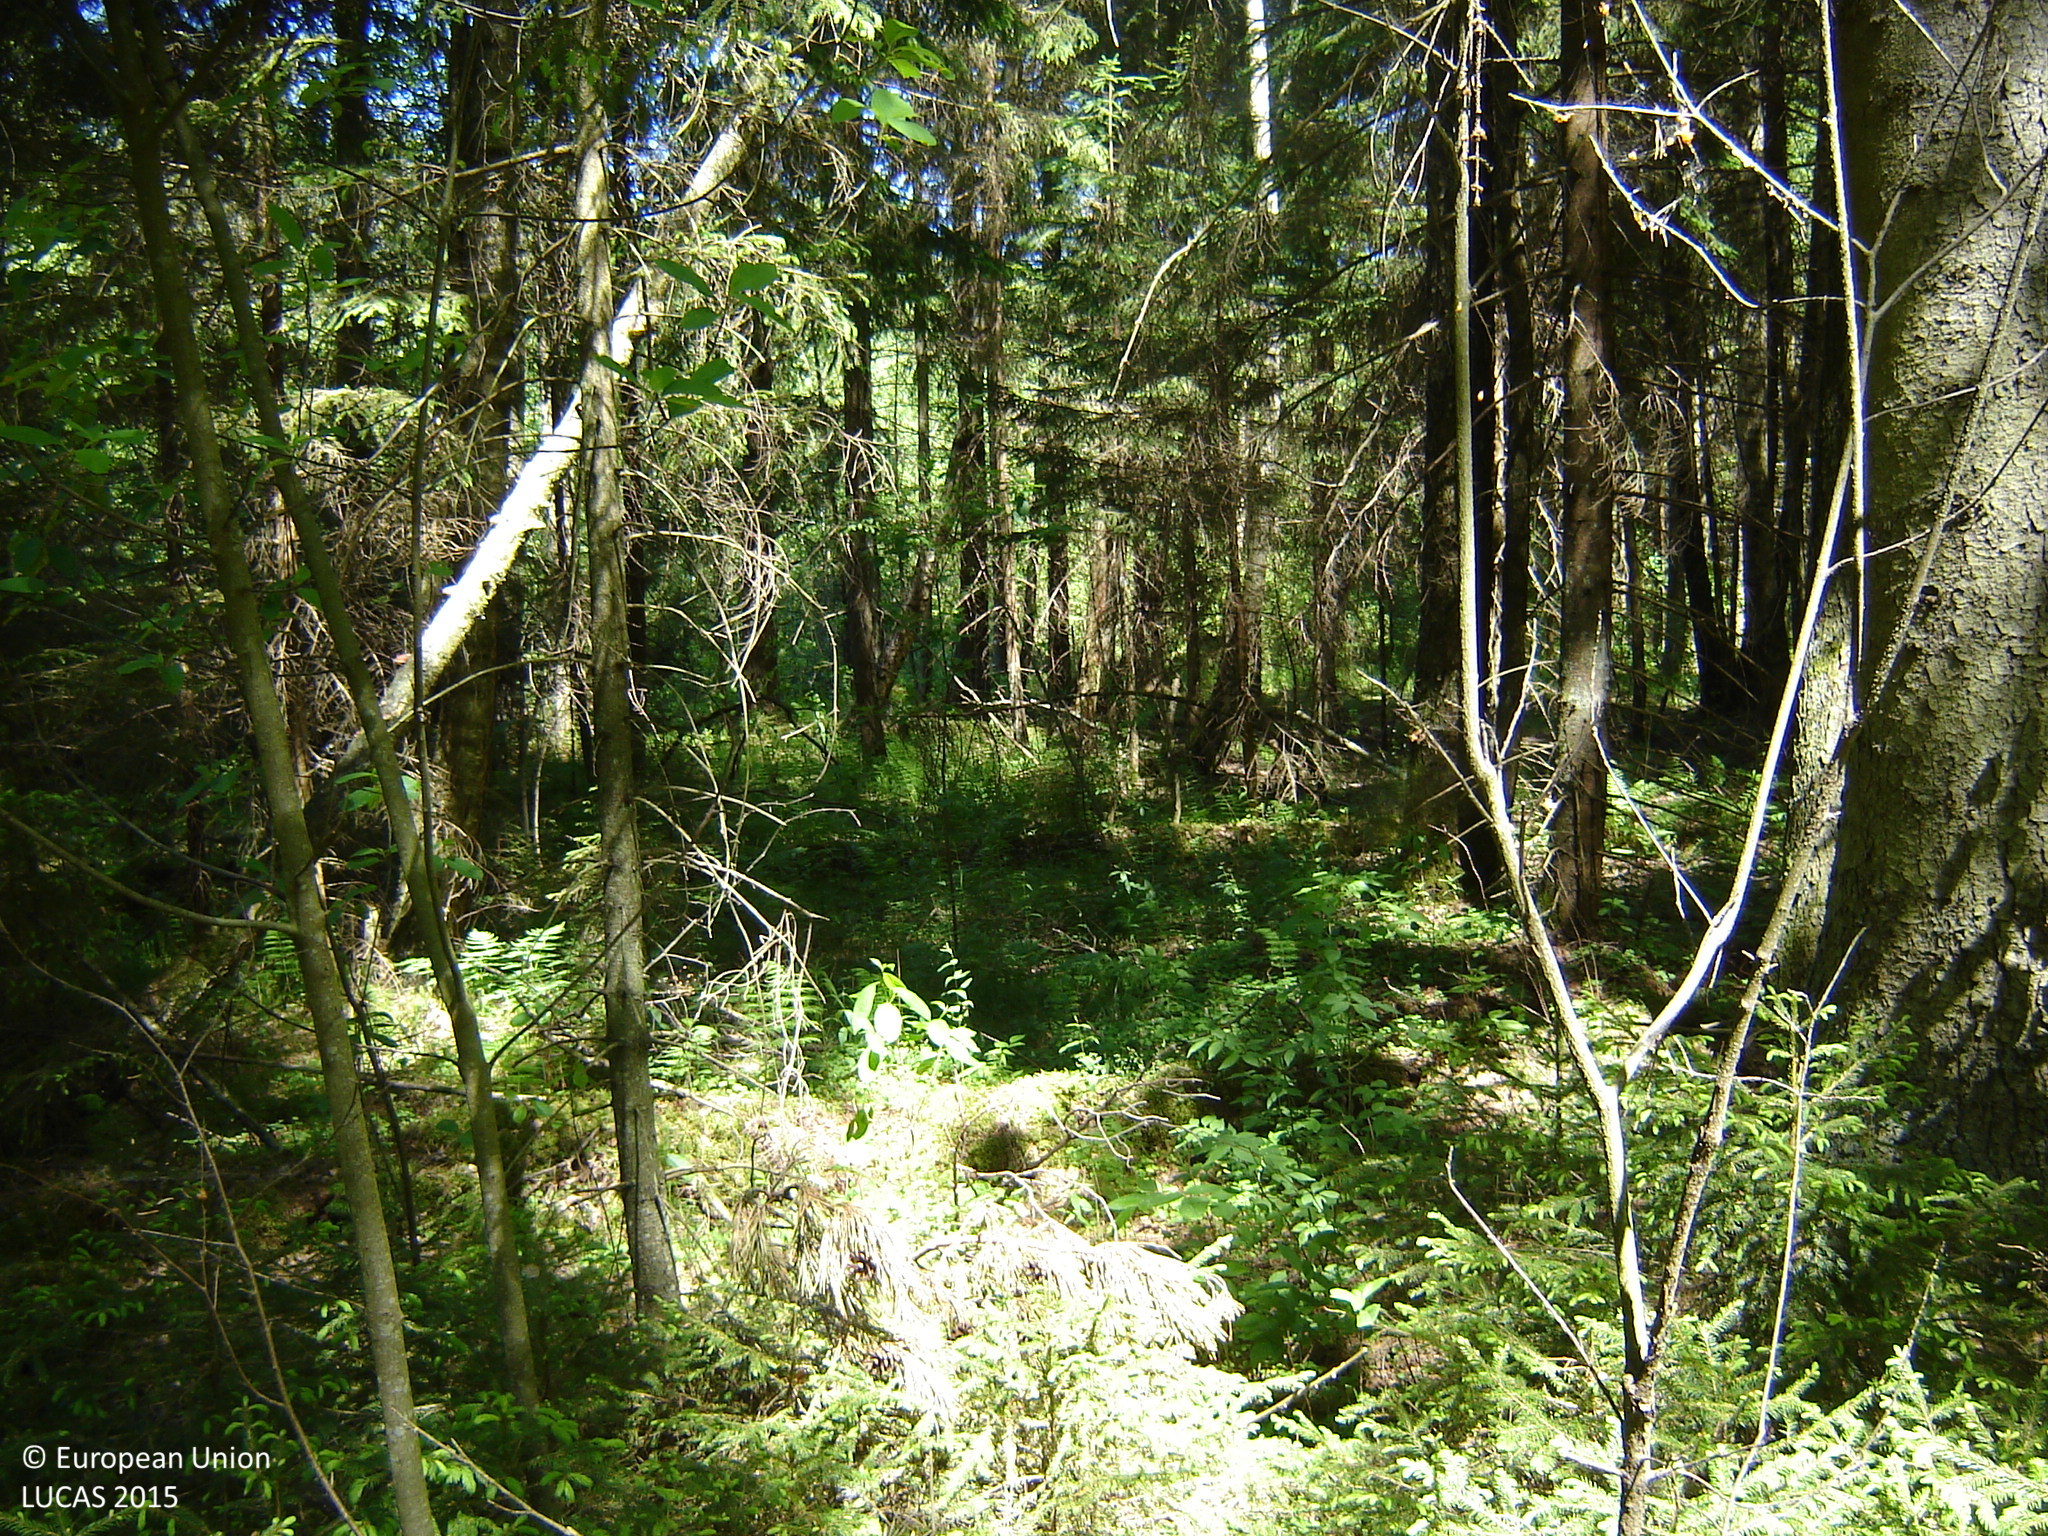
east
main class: Woodland
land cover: Spruce dominated coniferous woodland
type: hemiboreal forest and nemoral coniferous forest and mixed broadleaved-coniferous forest
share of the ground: > 75 %
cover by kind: coniferous forest trees 80 %, broadleaved forest trees 10 %, herbaceous plants 10 %
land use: Forestry
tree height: > 5 m
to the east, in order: Spruce dominated coniferous woodland; Broadleaved woodland; Ditches and canals; Broadleaved woodland; Spruce dominated mixed woodland
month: June
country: LT
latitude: 55.5932
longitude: 25.1422
